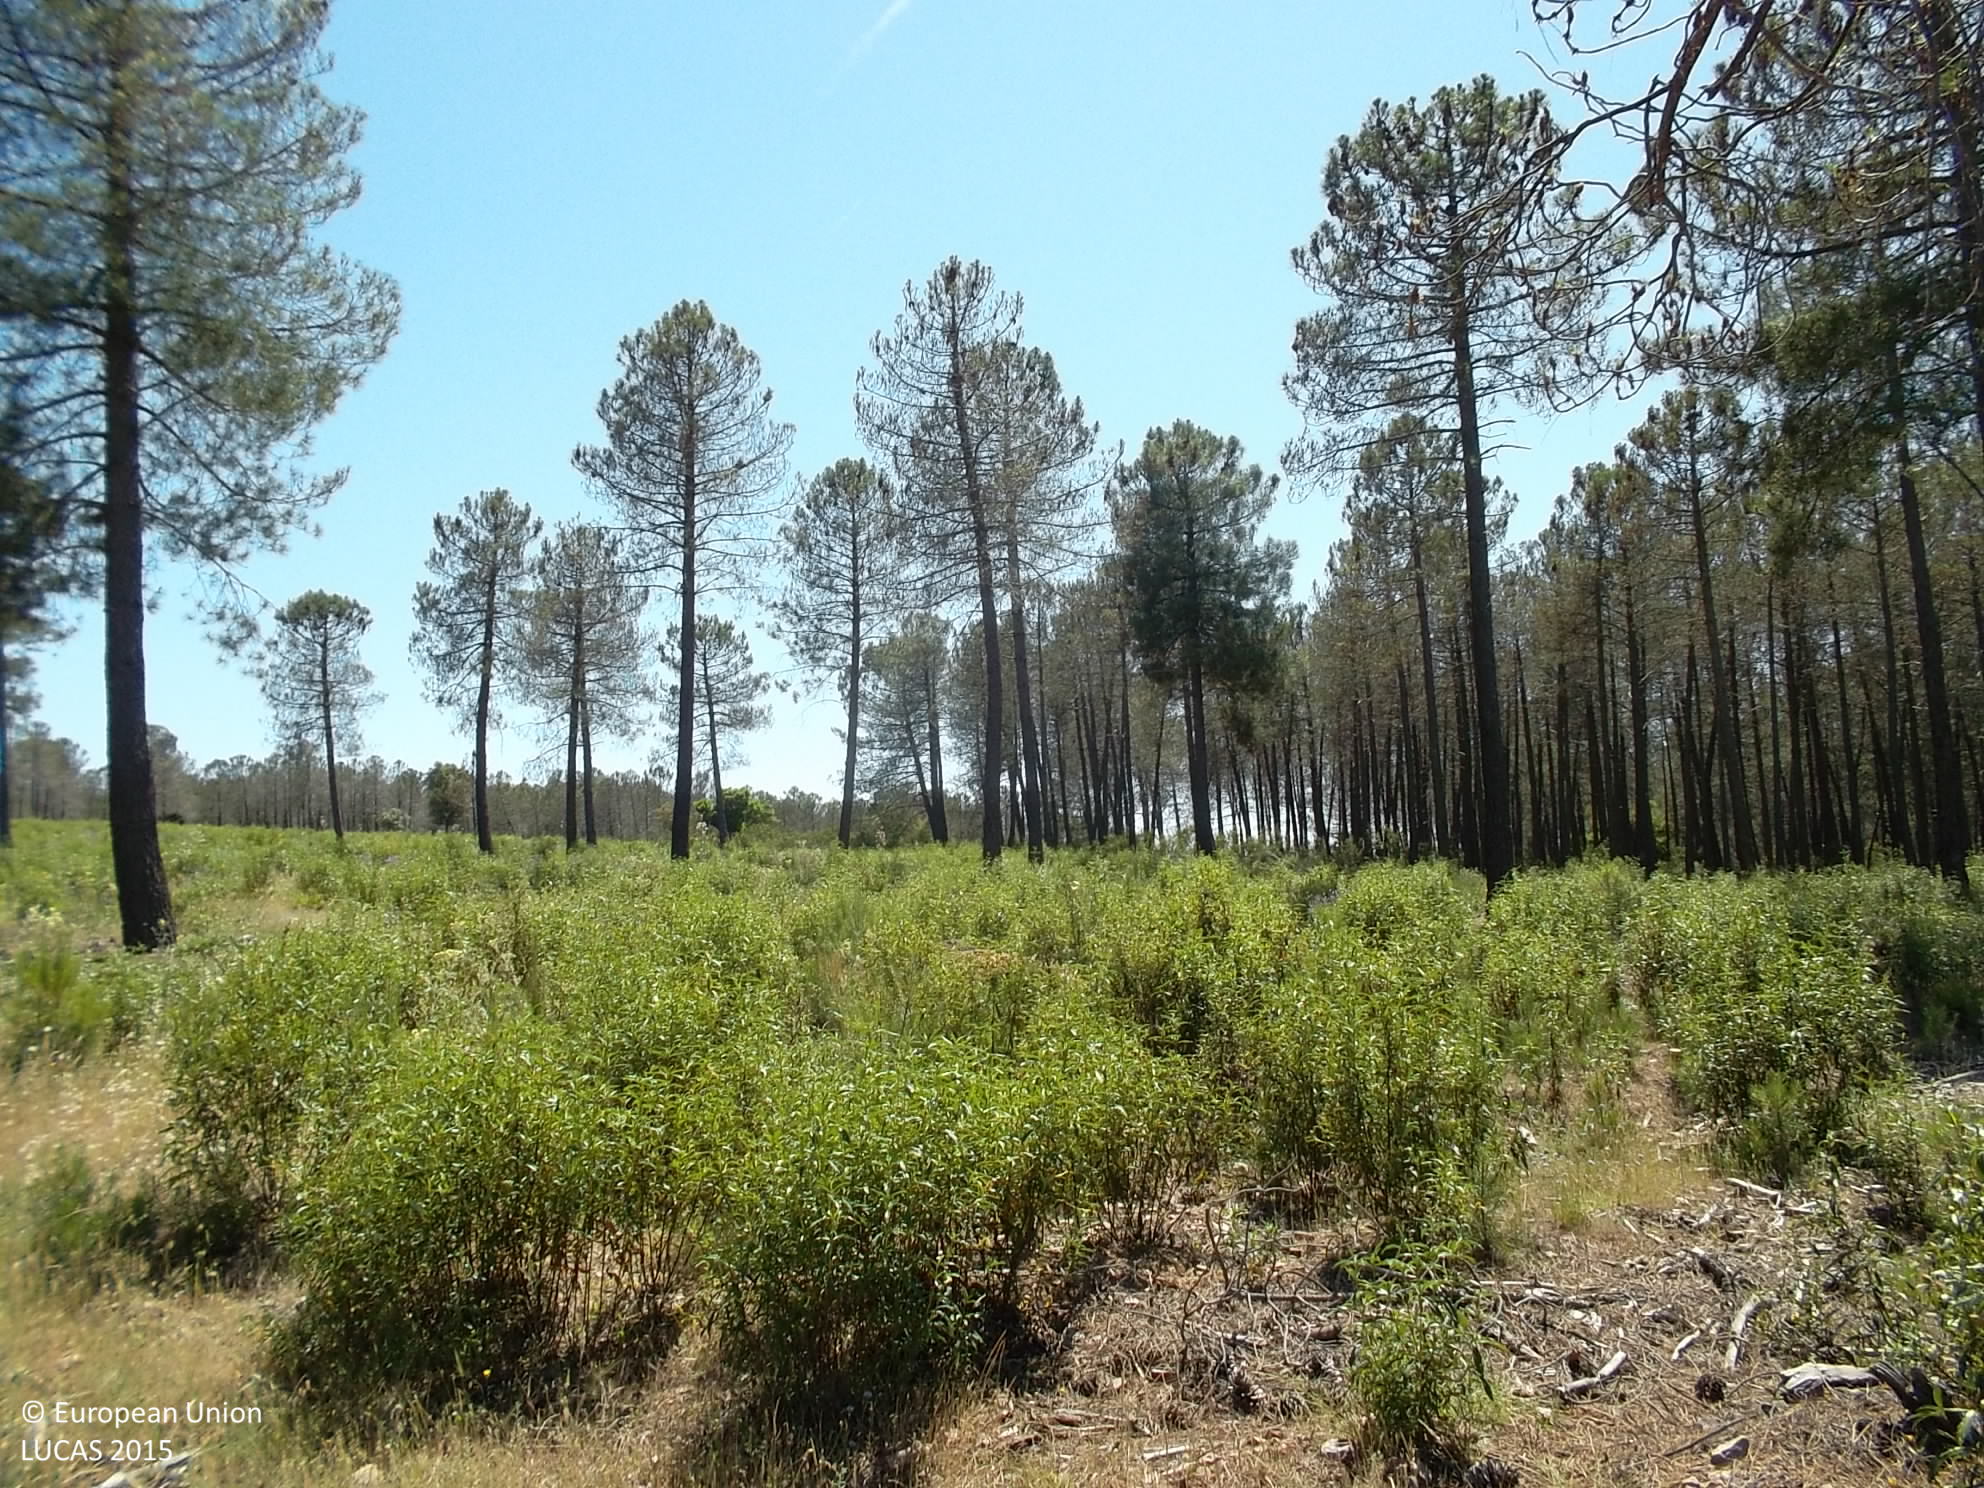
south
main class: Woodland
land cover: Pine dominated coniferous woodland
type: broadleaved evergreen forest
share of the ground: 25 - 50 %
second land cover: Spontaneously vegetated surfaces
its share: > 75 %
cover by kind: coniferous forest trees 40 %, herbaceous plants 30 %, consolidated bare surface 20 %, shrubs 10 %
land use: Forestry
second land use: Agriculture (excluding fallow land and kitchen gardens)
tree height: > 5 m
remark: Clear cut
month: May
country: ES
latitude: 38.8197
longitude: -4.4797
